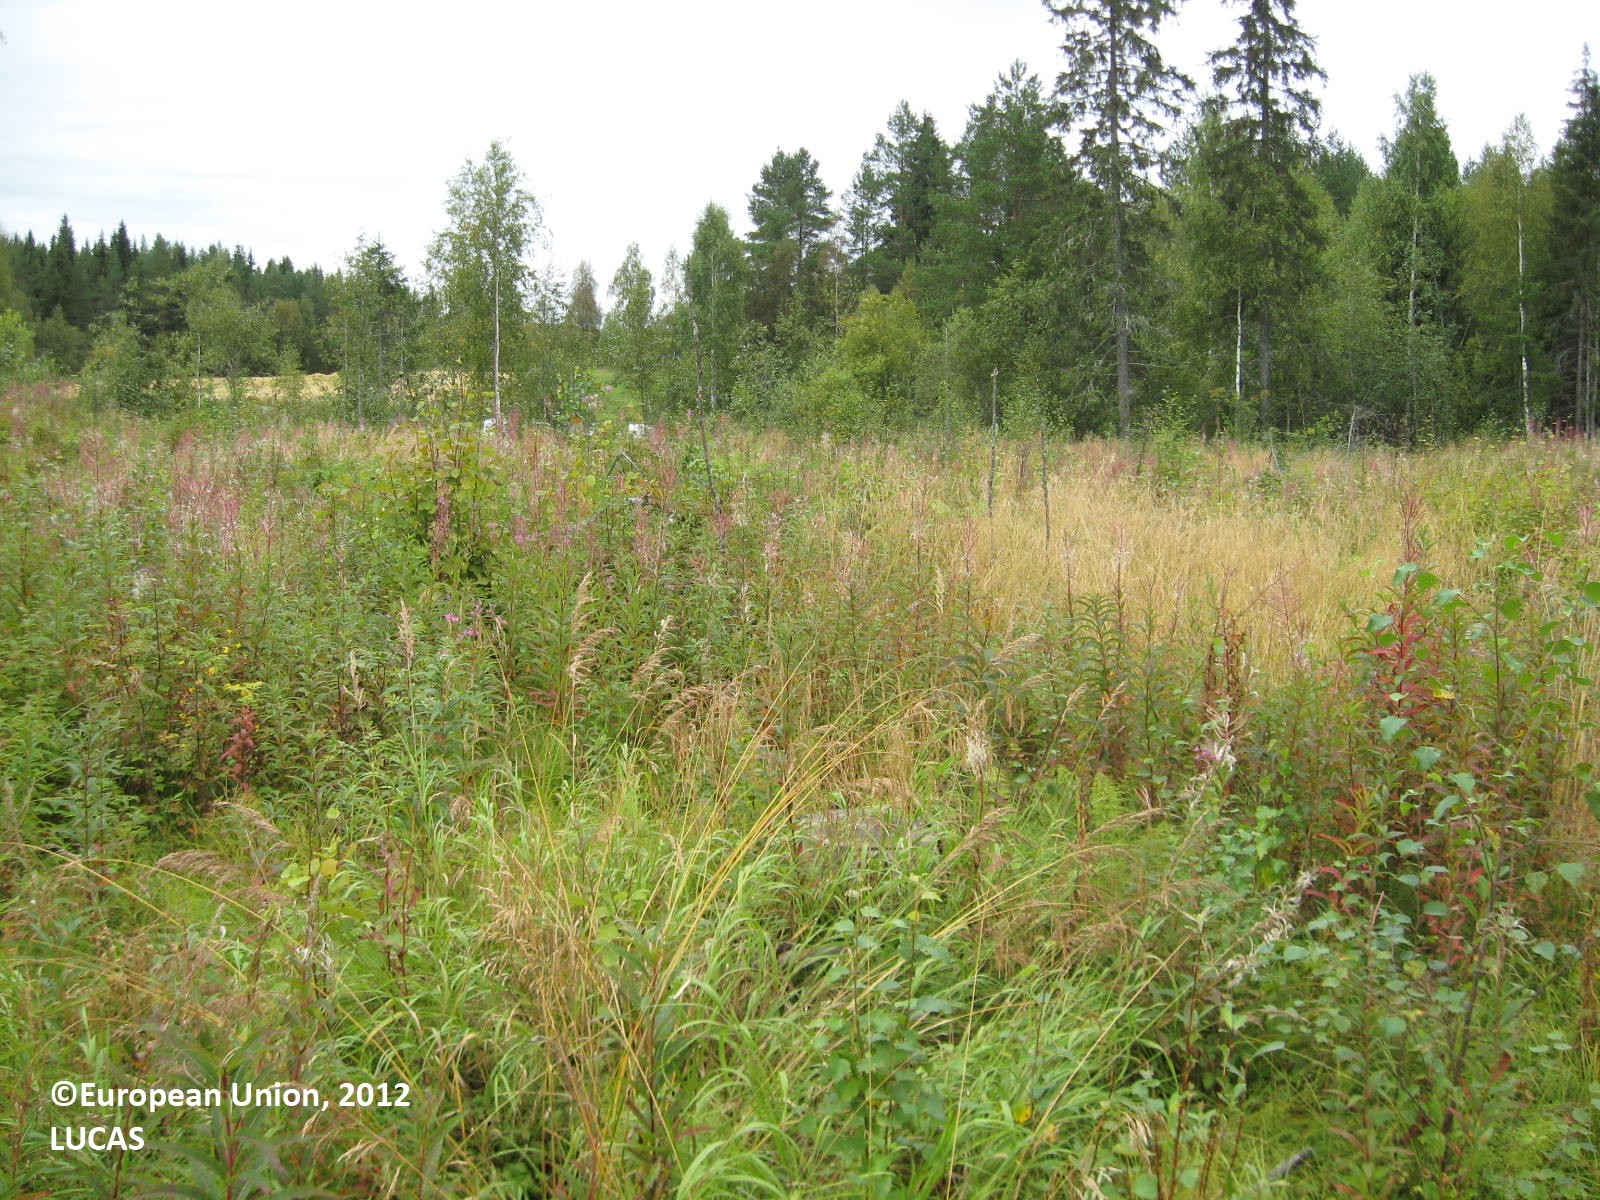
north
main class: Shrubland
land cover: Shrubland without tree cover
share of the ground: 50 - 75 %
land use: Forestry
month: August
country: FI
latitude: 63.6603
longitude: 29.0132
